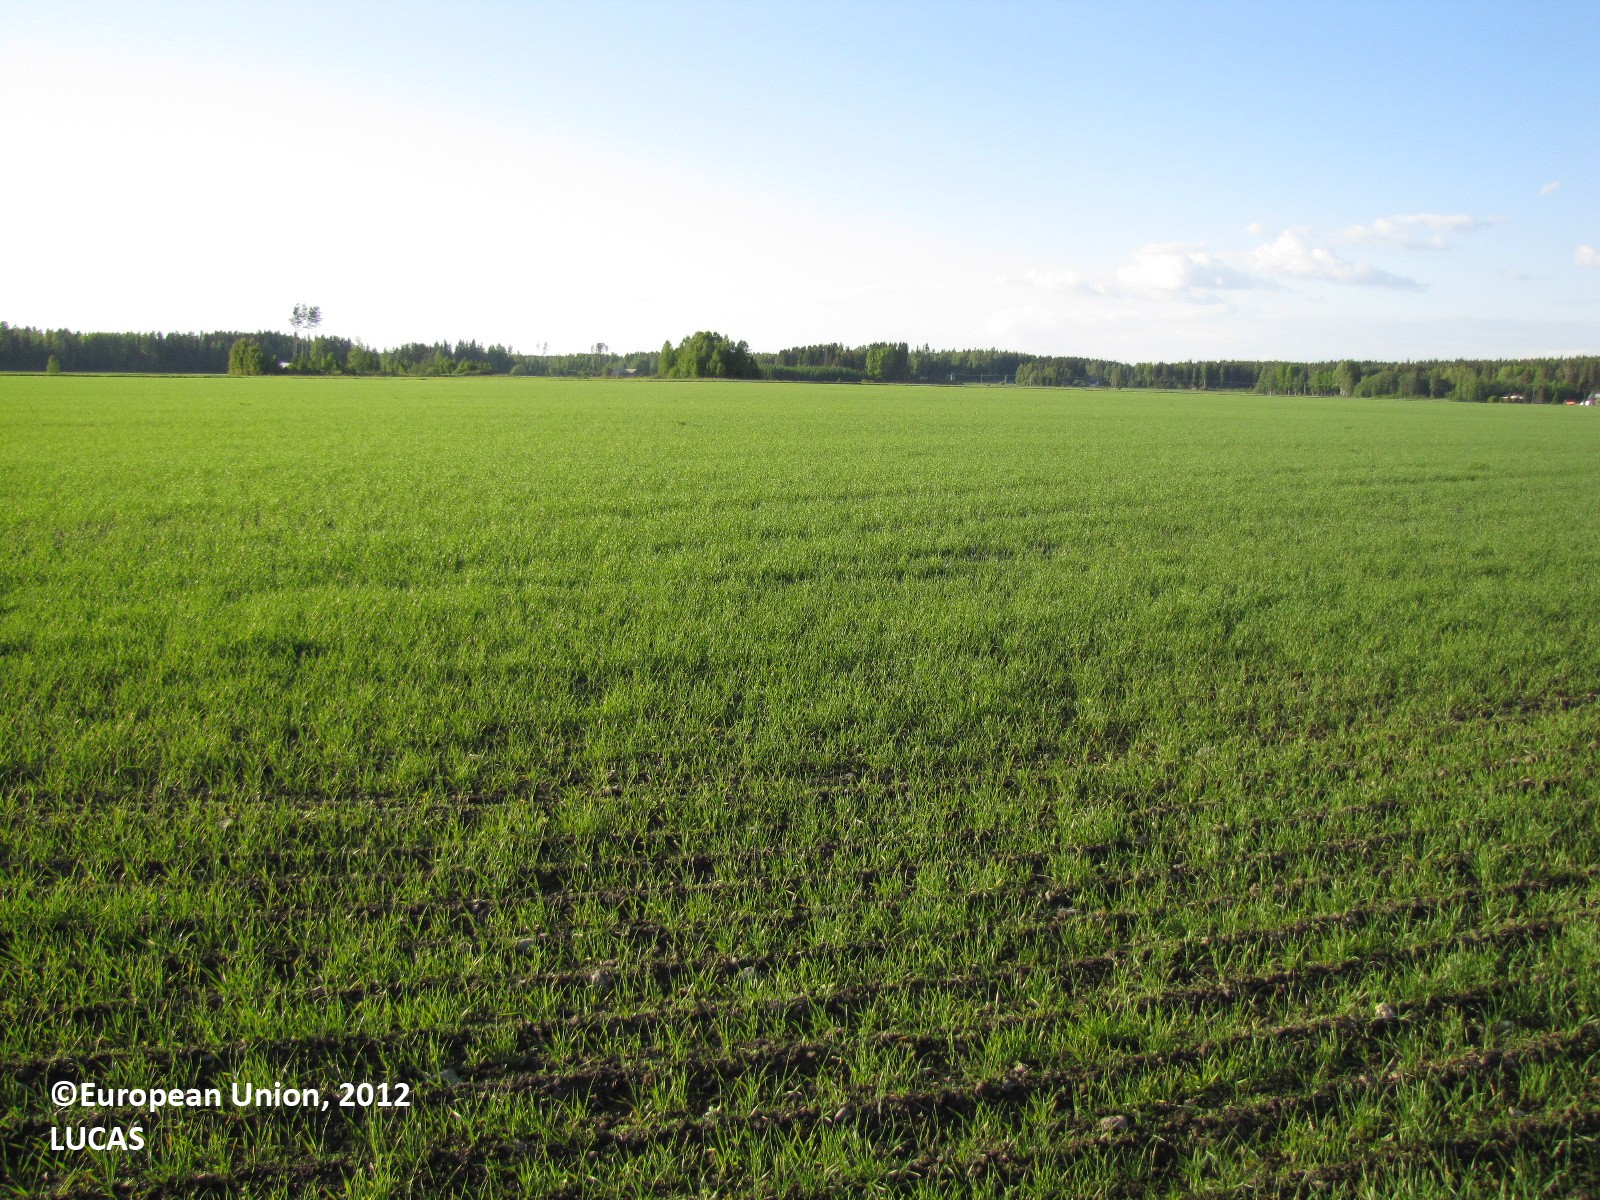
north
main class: Cropland
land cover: Common wheat
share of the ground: 25 - 50 %
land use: Agriculture (excluding fallow land and kitchen gardens)
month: June
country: FI
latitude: 61.2095
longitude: 22.9340
